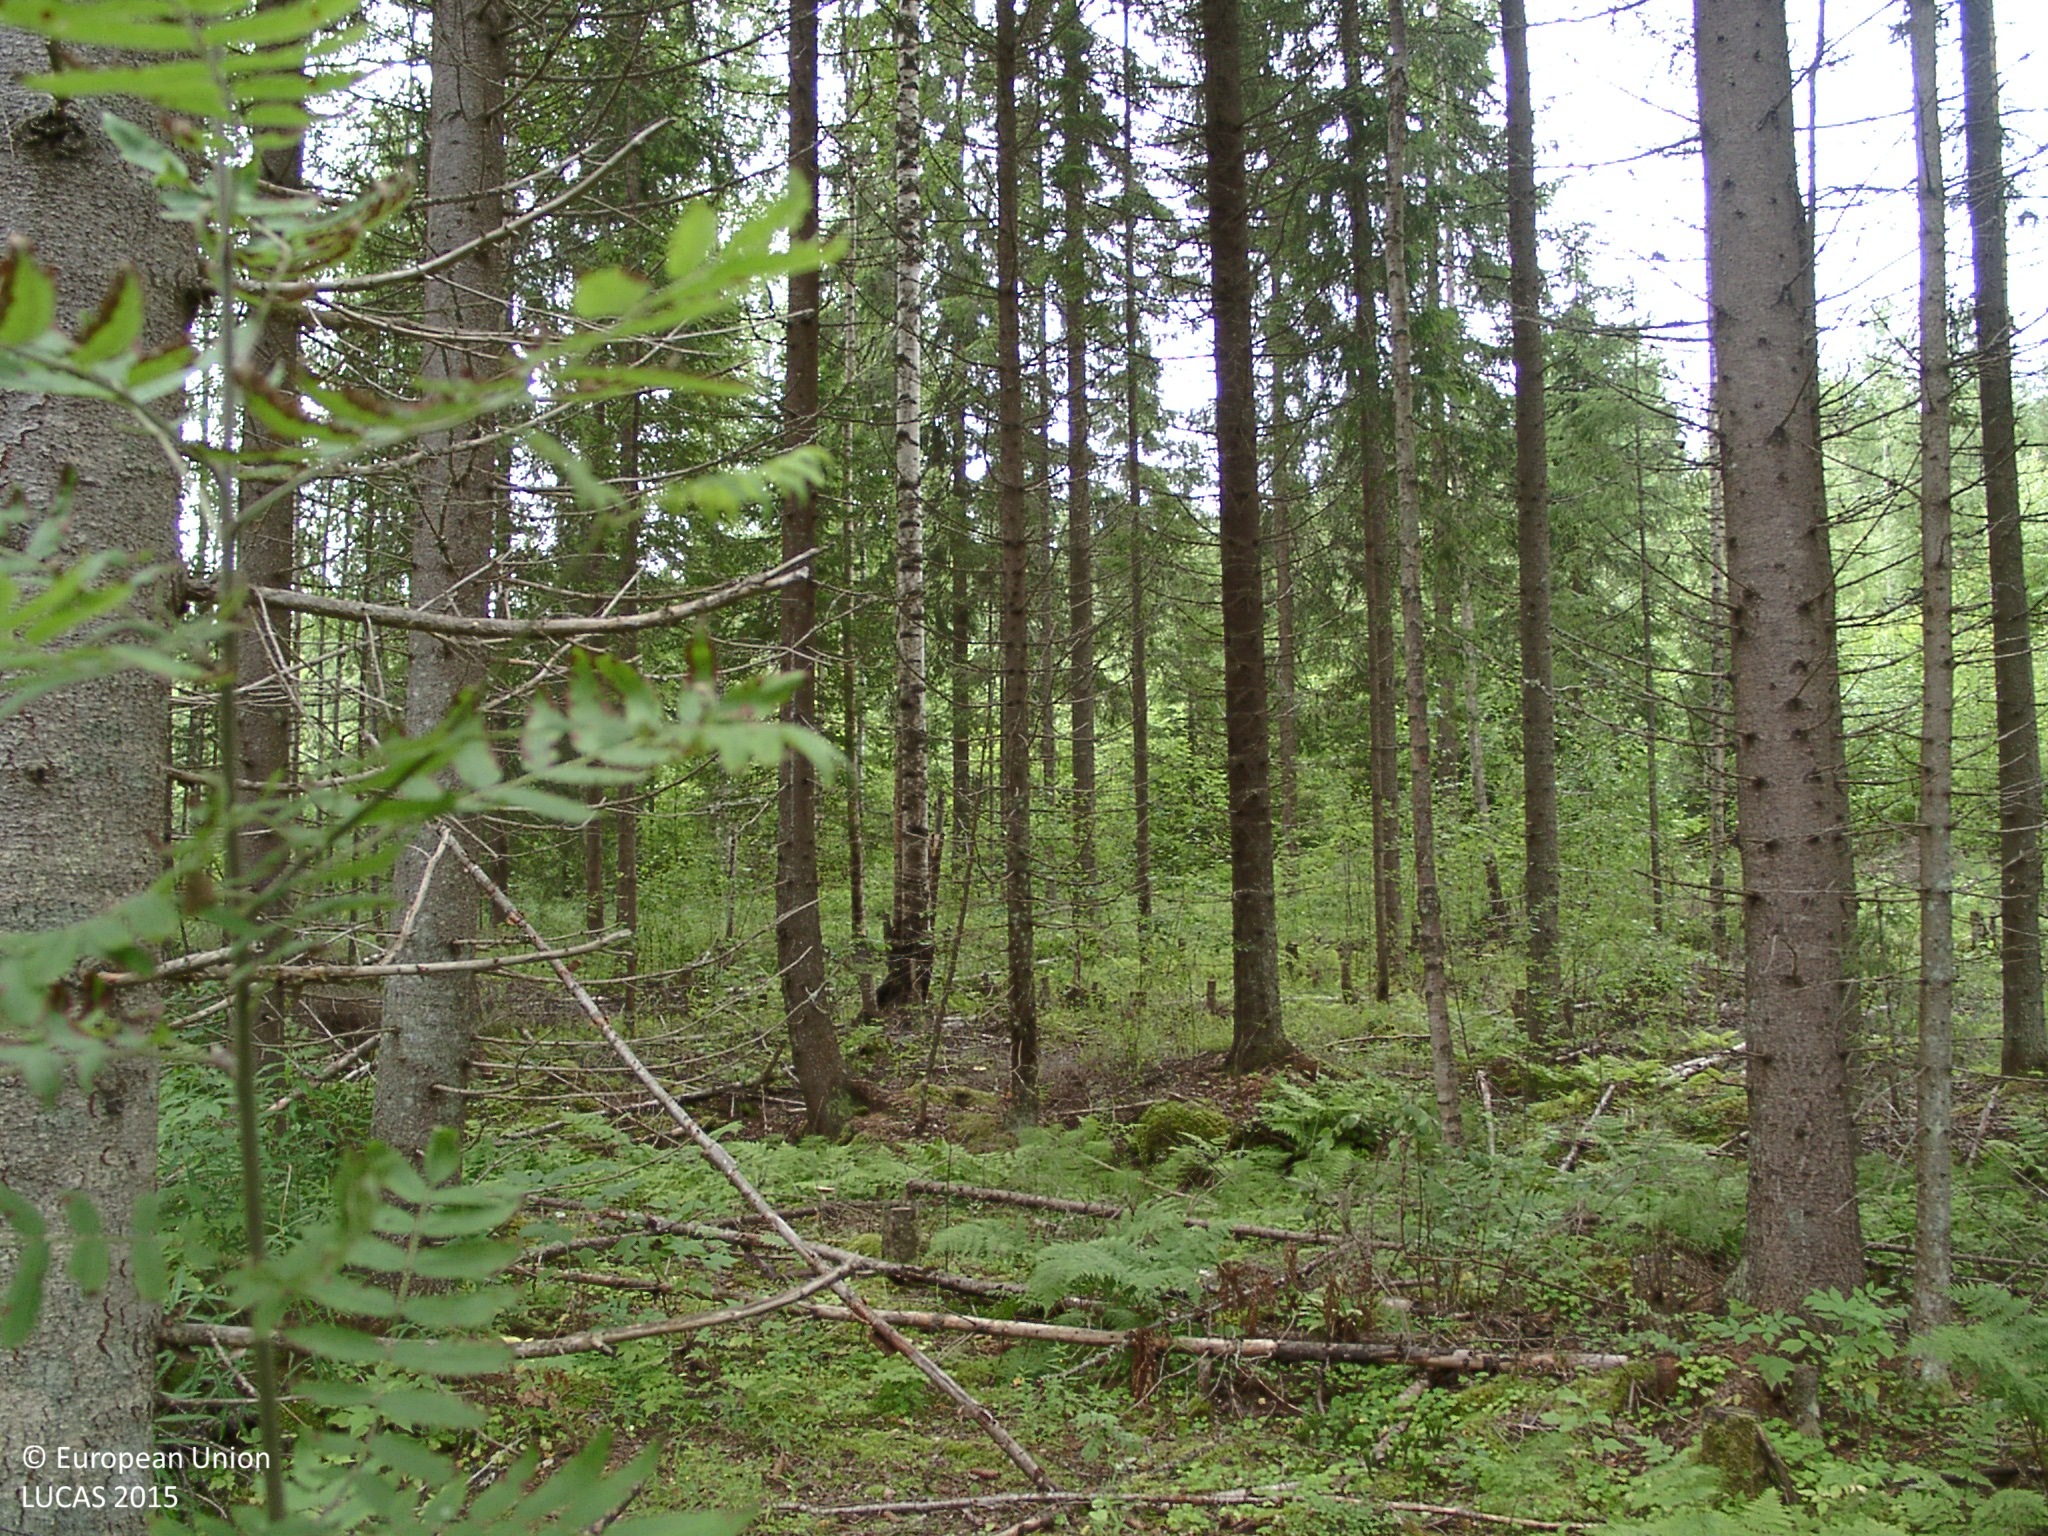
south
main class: Woodland
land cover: Spruce dominated mixed woodland
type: boreal forest
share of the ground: 50 - 75 %
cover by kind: coniferous forest trees 35 %, broadleaved forest trees 35 %, shrubs 15 %, herbaceous plants 15 %
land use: Forestry
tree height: > 5 m
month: July
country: FI
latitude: 62.2594
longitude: 26.0541
